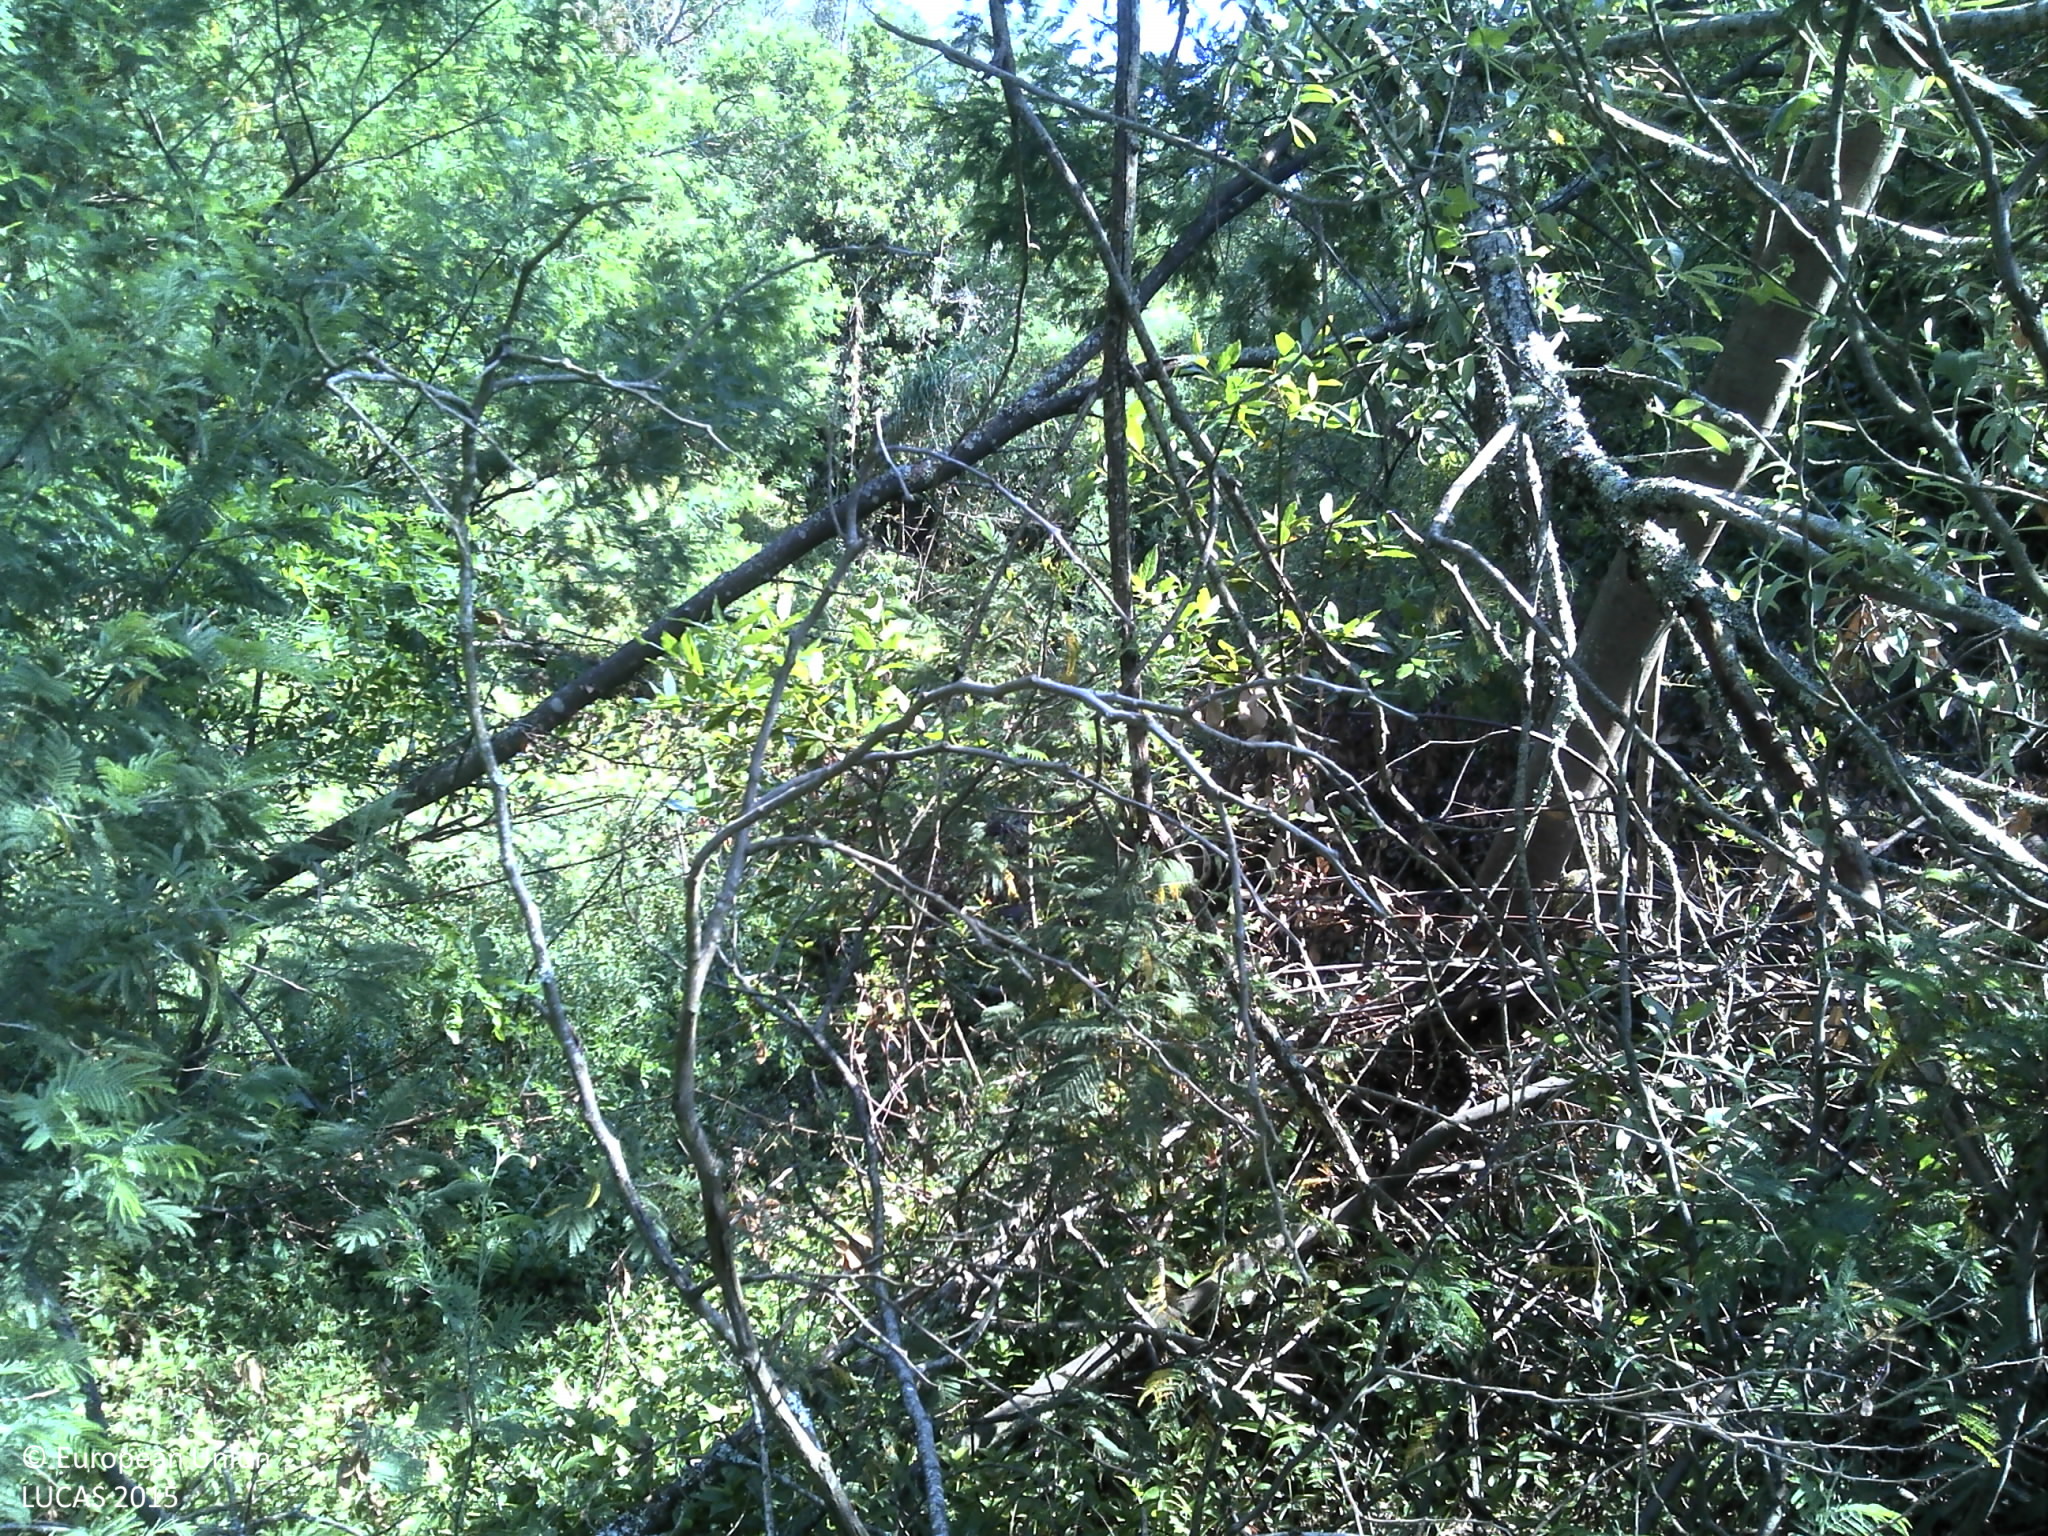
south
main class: Woodland
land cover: Broadleaved woodland
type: floodplain forest
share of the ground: > 75 %
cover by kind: broadleaved forest trees 70 %, unconsolidated bare surface 15 %, herbaceous plants 10 %, shrubs 5 %
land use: Semi-natural and natural areas not in use
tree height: > 5 m
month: June
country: PT
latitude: 42.1519
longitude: -8.2003
